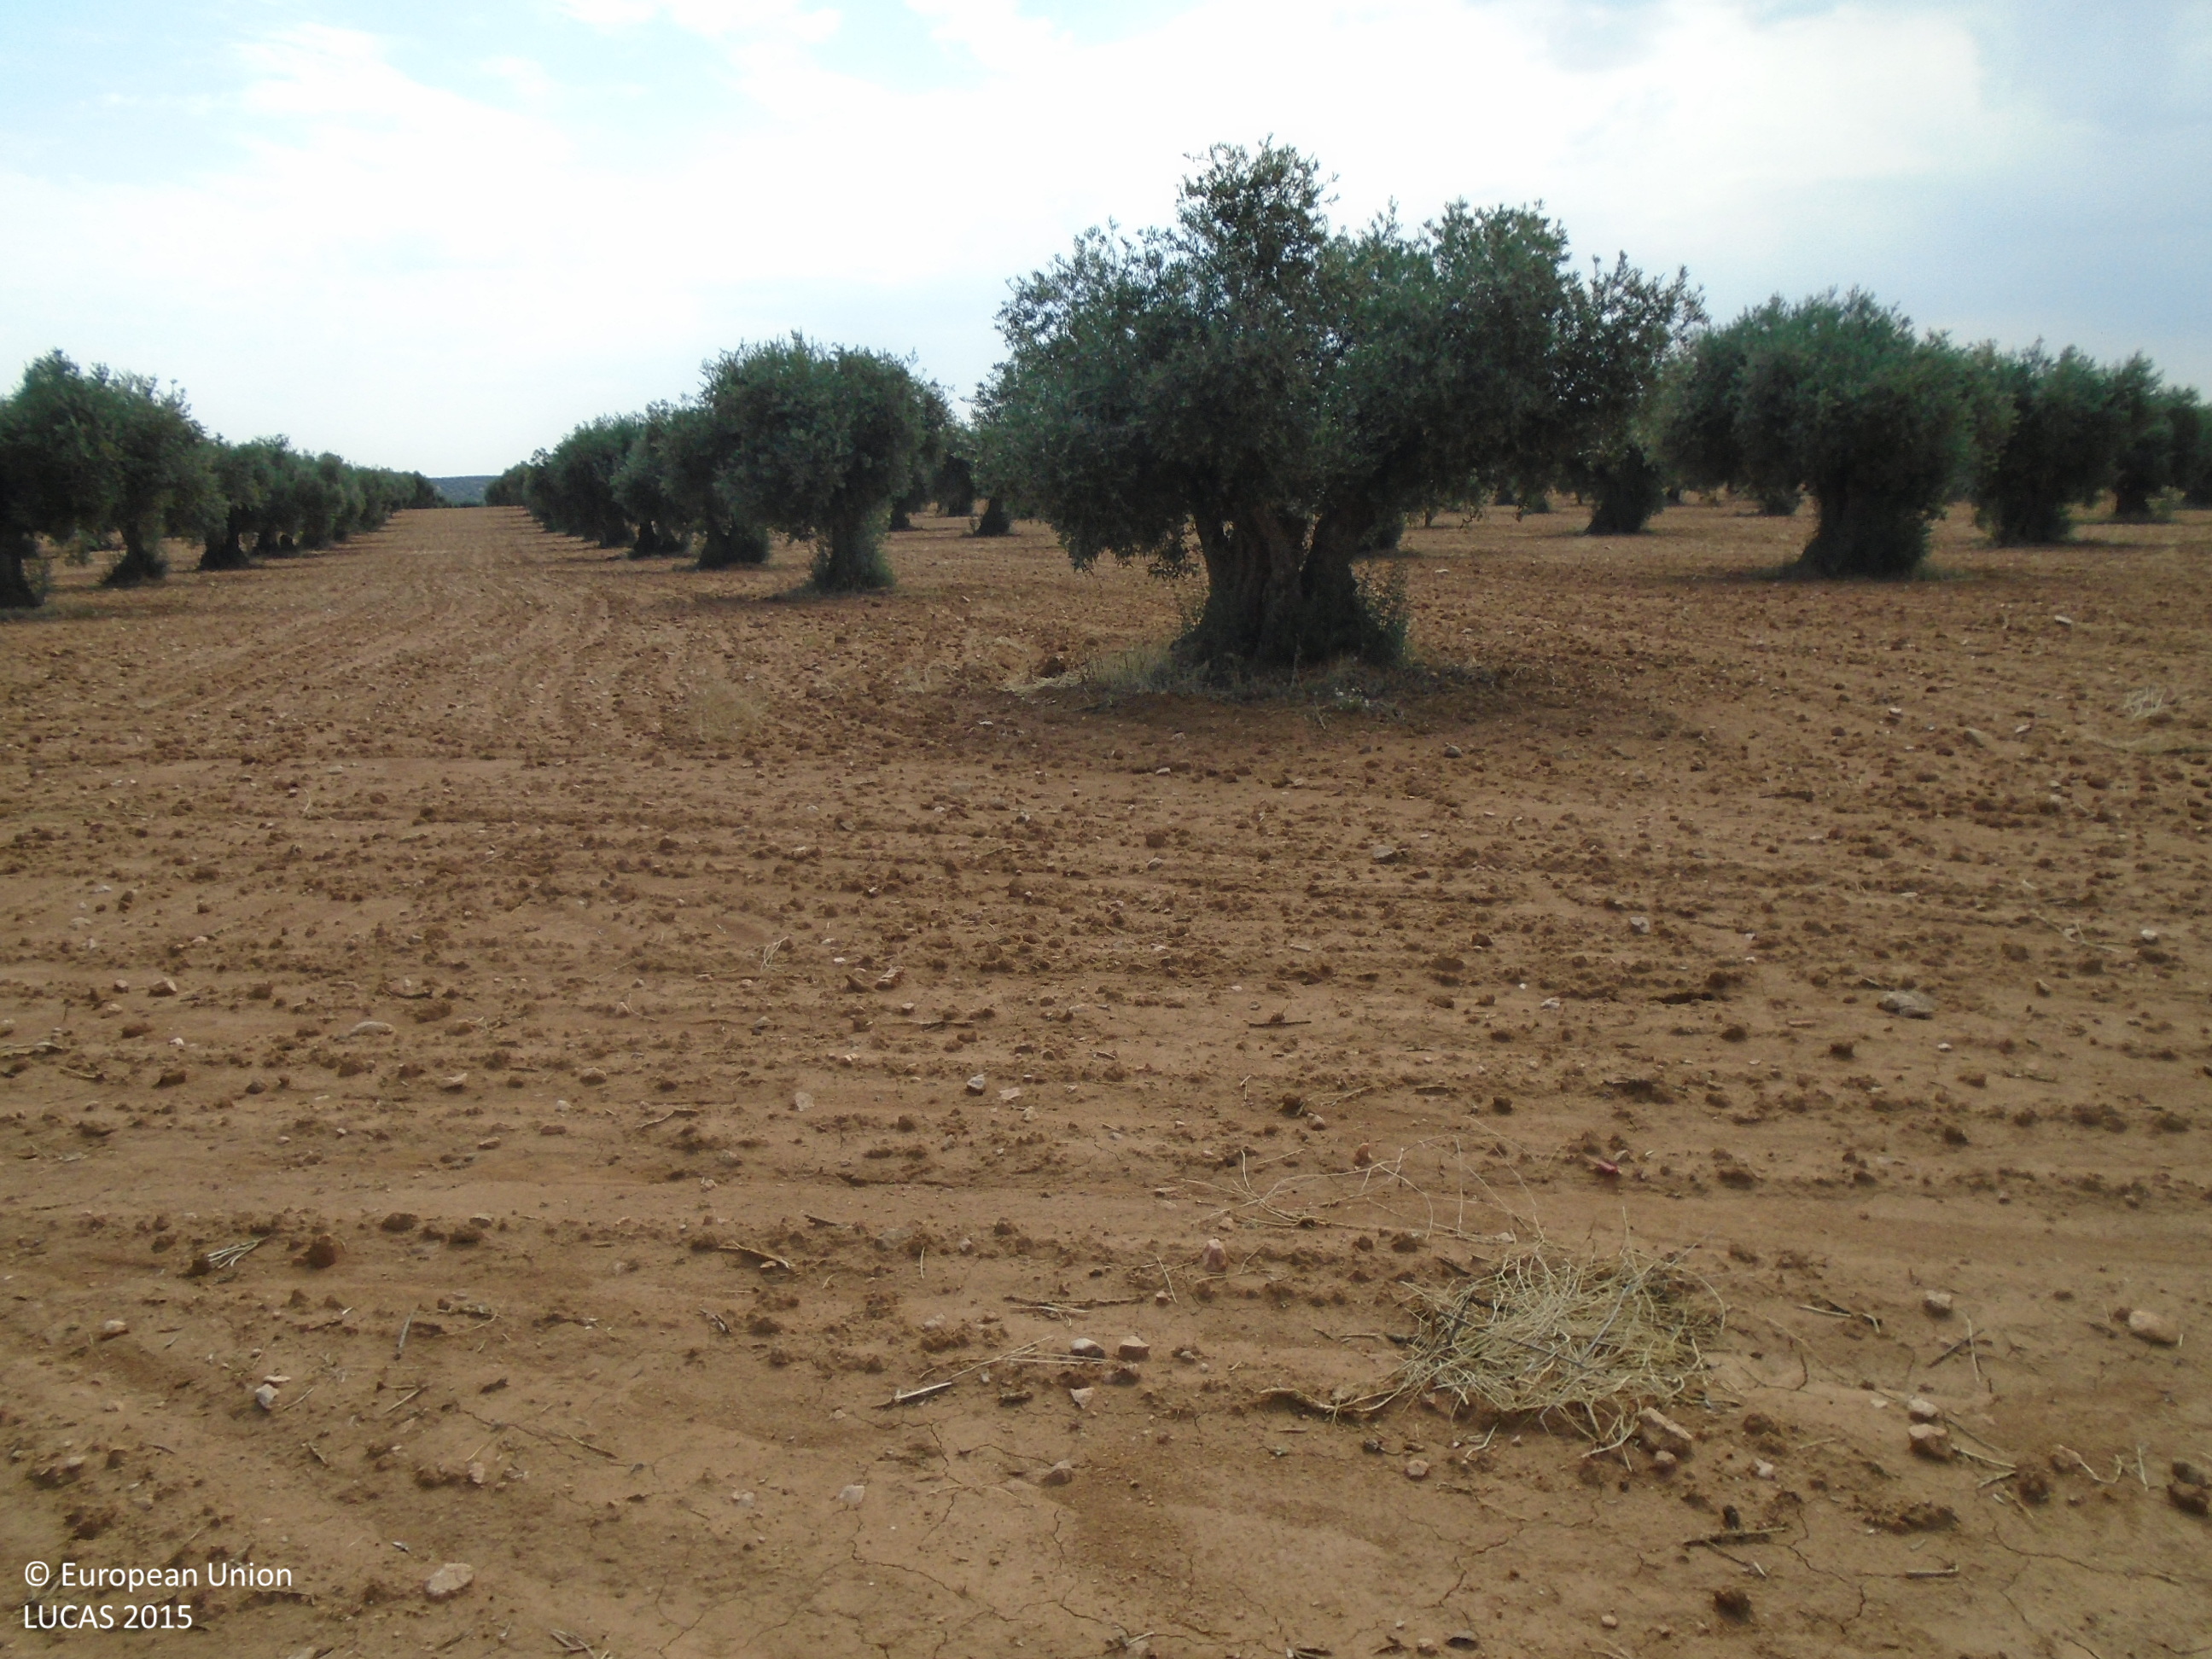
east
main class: Cropland
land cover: Olive groves
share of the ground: 10 - 25 %
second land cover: Other bare soil
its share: > 75 %
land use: Agriculture (excluding fallow land and kitchen gardens)
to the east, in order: Olive groves; Other bare soil
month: June
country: ES
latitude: 39.7647
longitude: -4.1714
